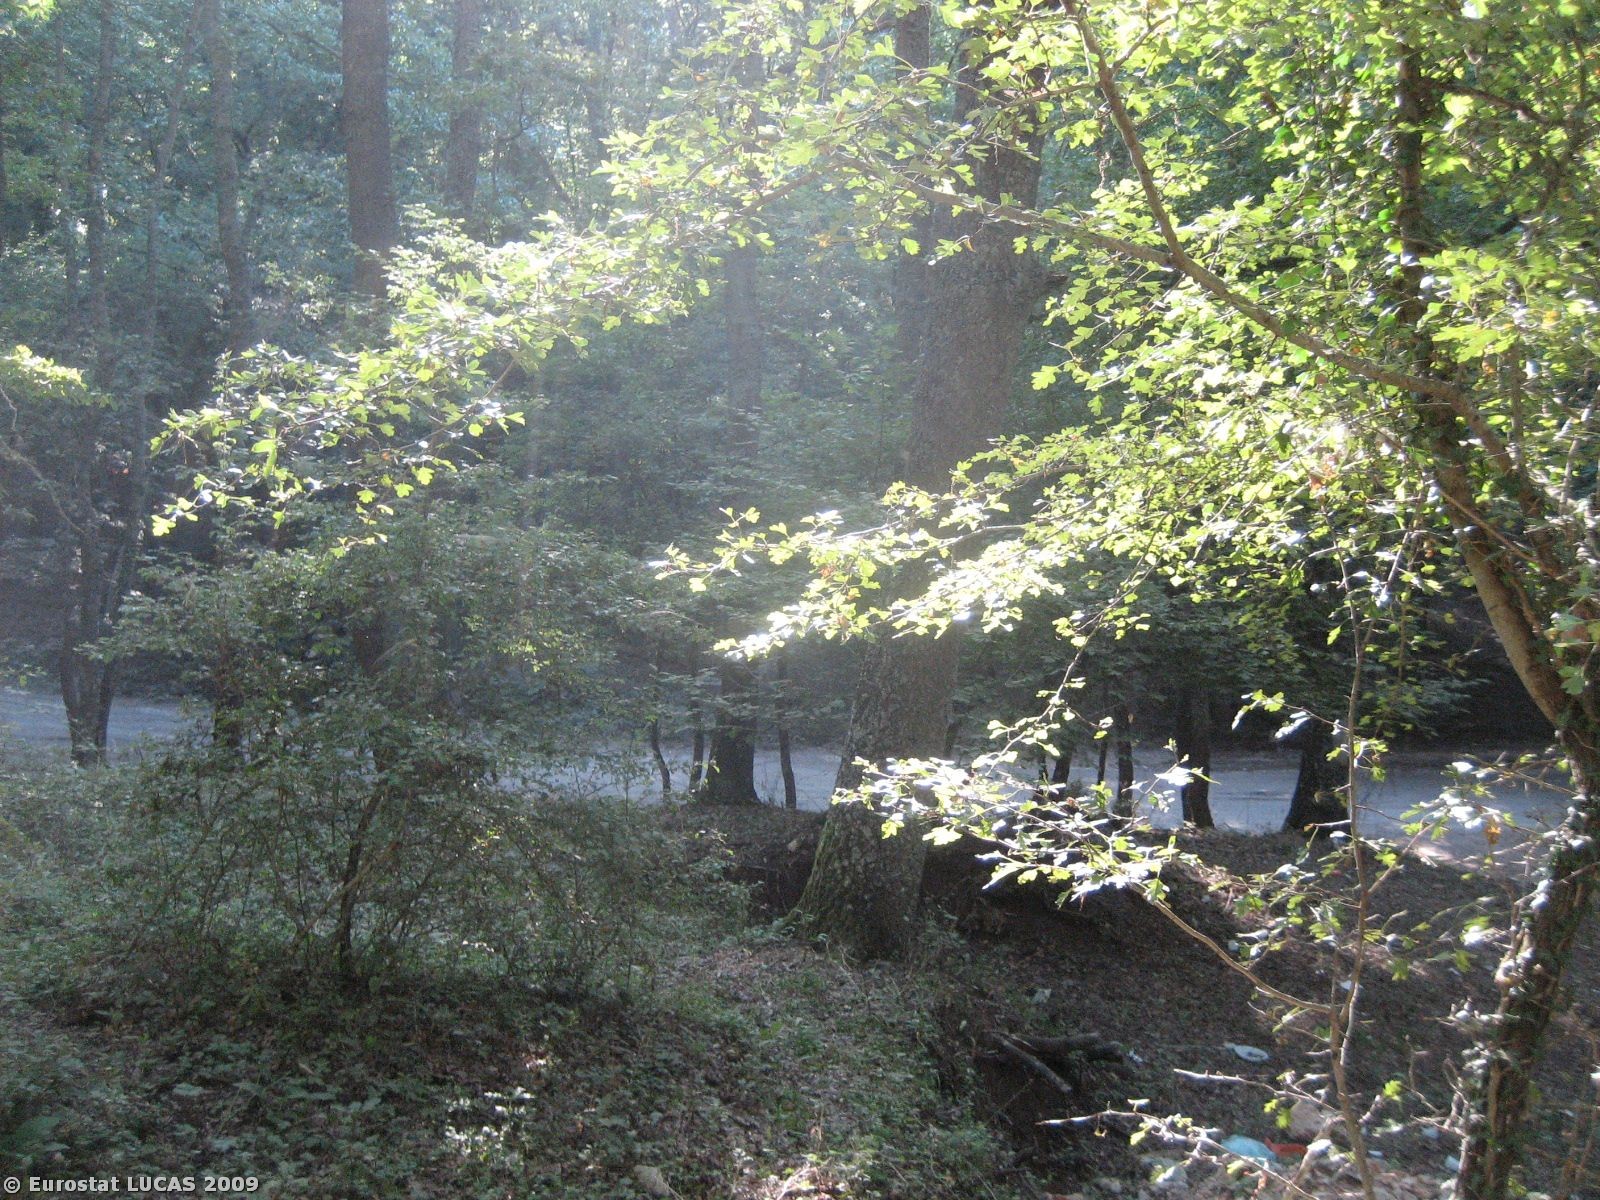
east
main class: Woodland
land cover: Broadleaved woodland
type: mesophytic deciduous forest
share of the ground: > 75 %
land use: Agriculture (excluding fallow land and kitchen gardens)
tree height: > 5 m
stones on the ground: 10 - 25 %
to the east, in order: Broadleaved woodland; Paved roads, cycling and walking lanes; Broadleaved woodland
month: July
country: IT
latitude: 41.7167
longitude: 15.6682
